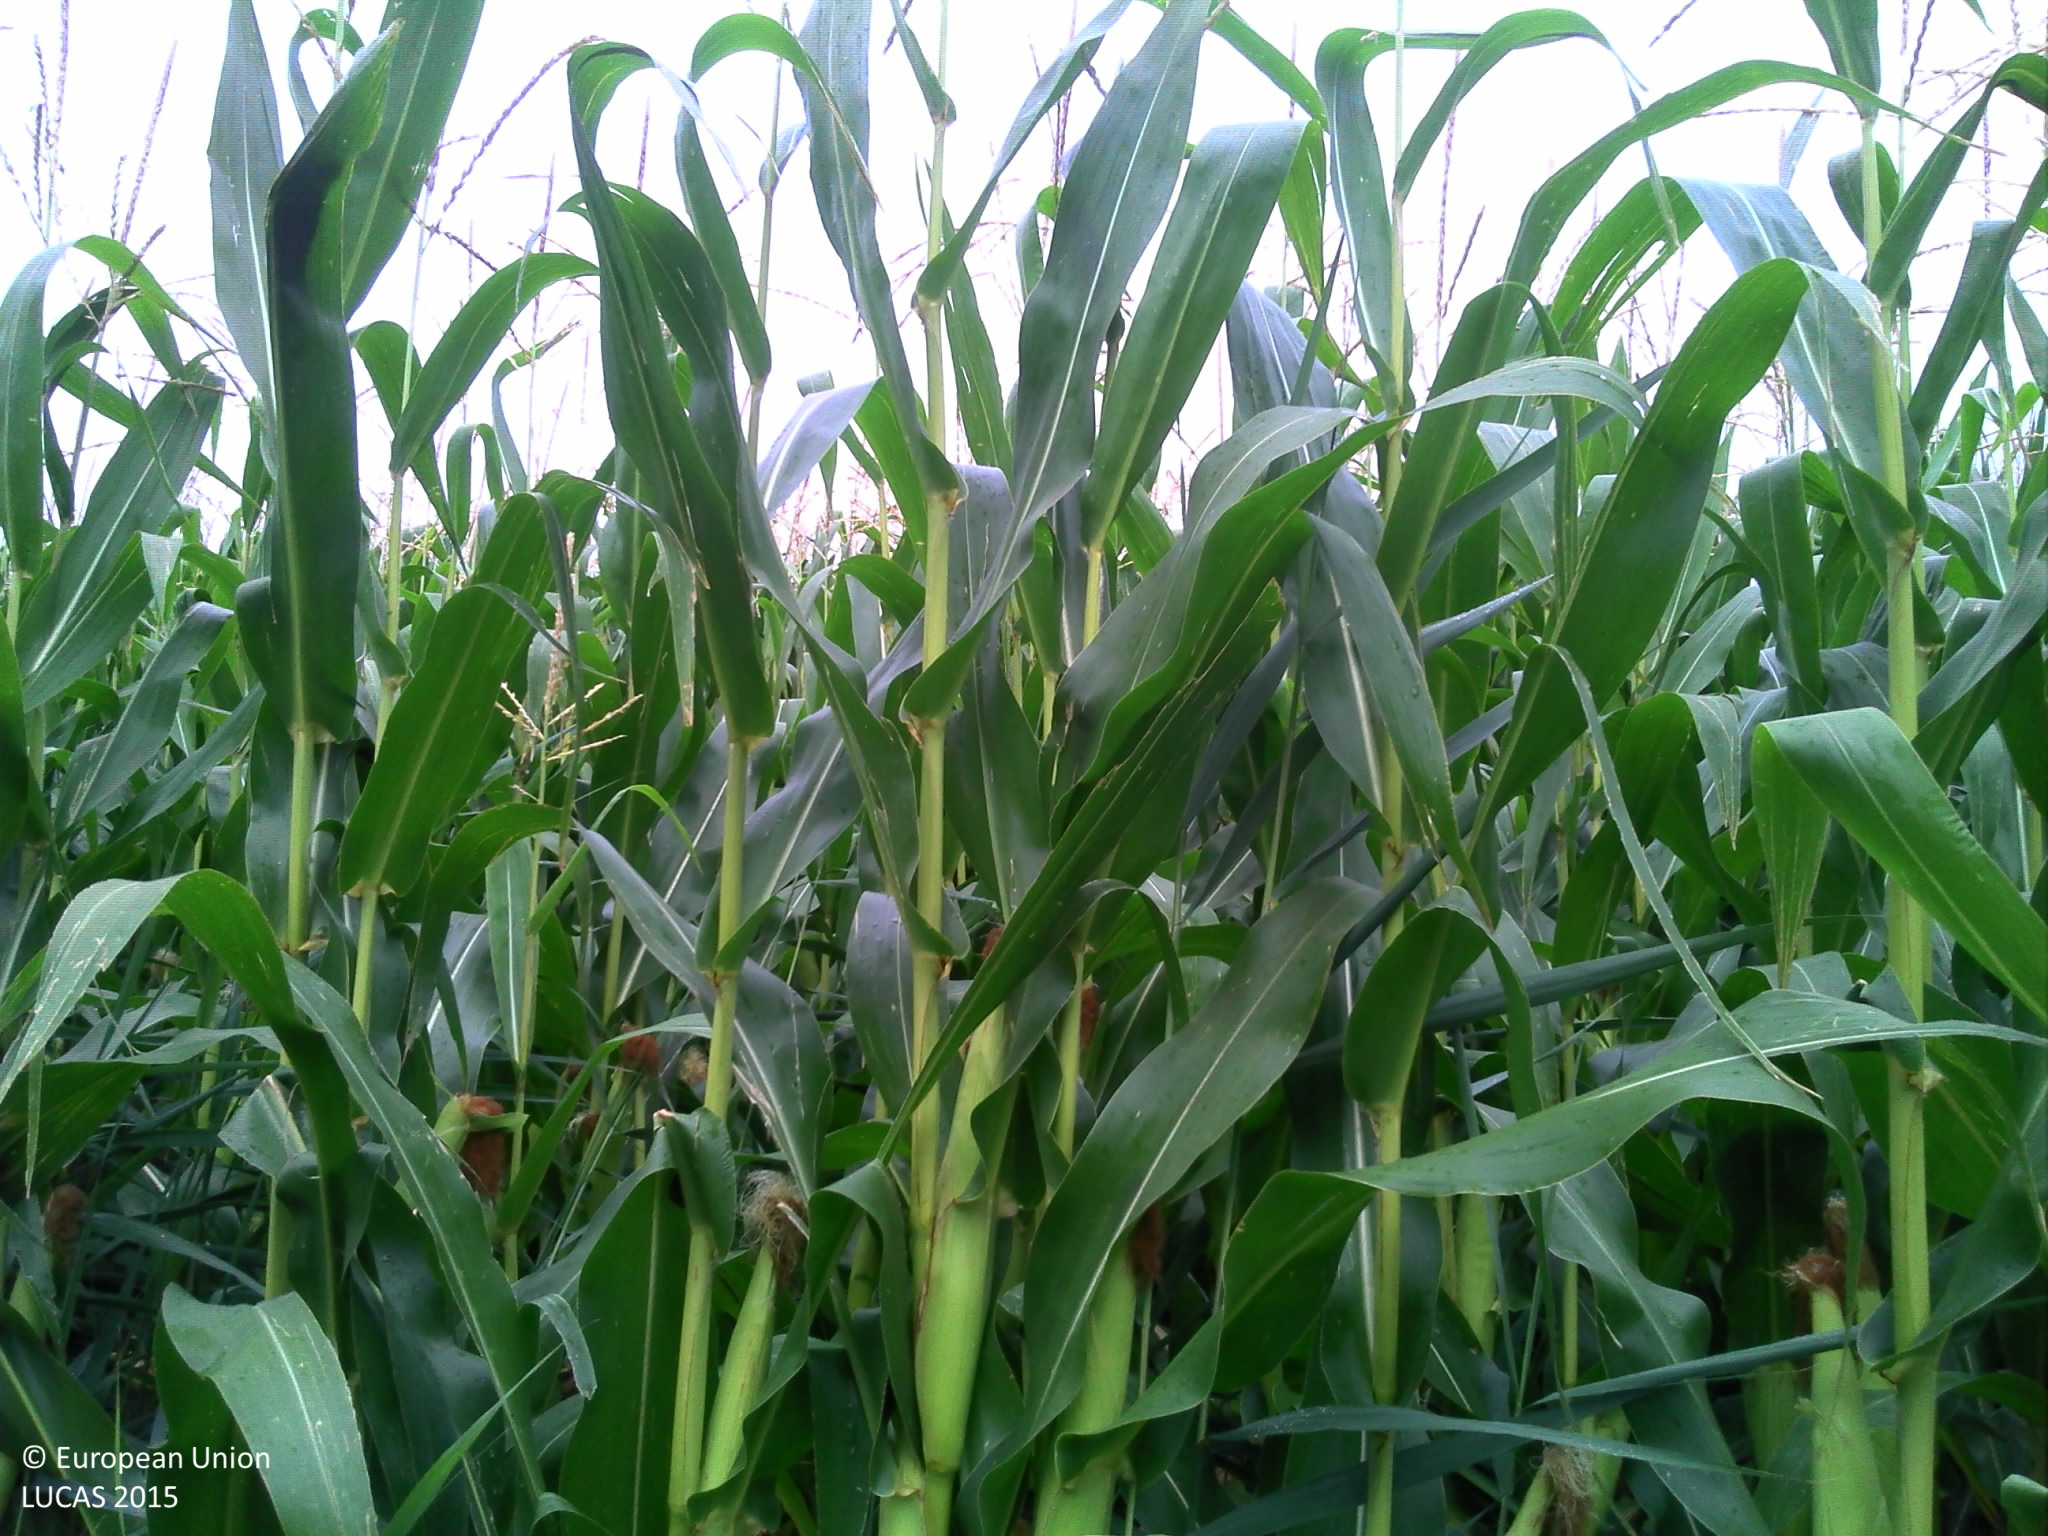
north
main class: Cropland
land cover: Maize
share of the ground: > 75 %
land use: Agriculture (excluding fallow land and kitchen gardens)
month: August
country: FR
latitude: 48.9262
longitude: 8.0489
